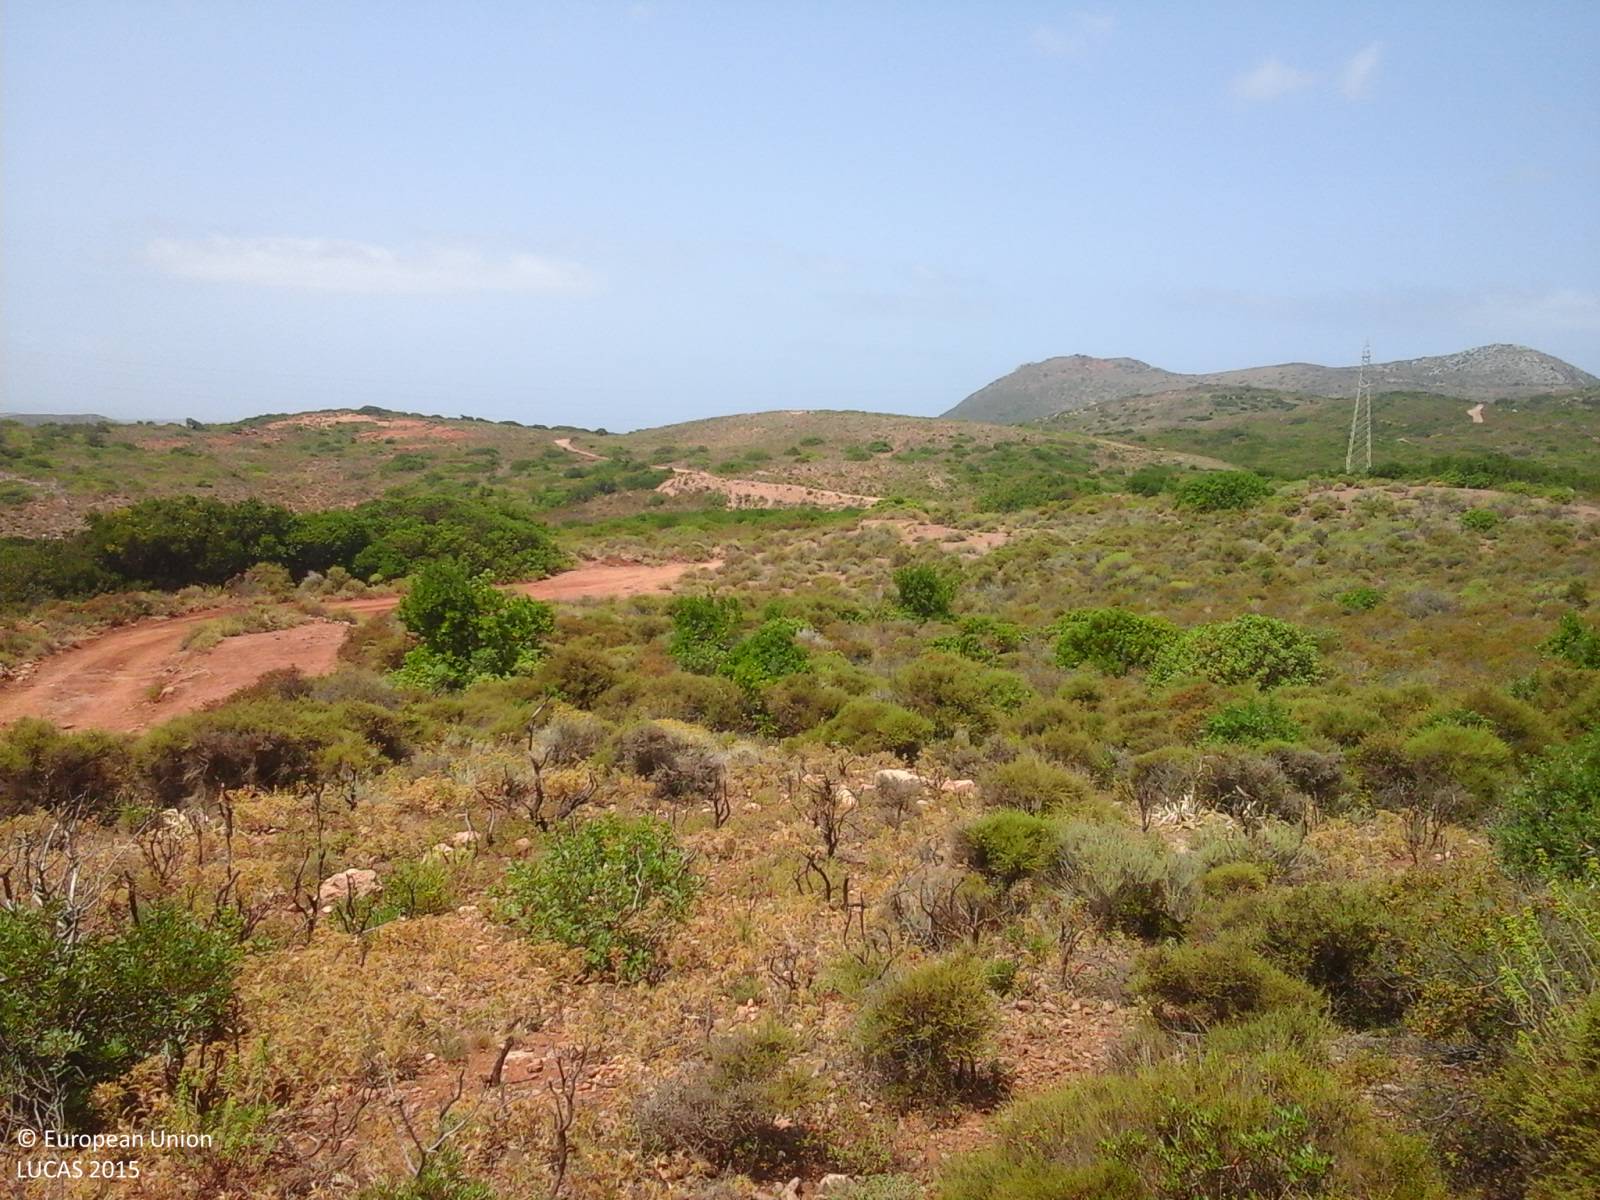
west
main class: Shrubland
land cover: Shrubland without tree cover
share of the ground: > 75 %
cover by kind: shrubs 65 %, unconsolidated bare surface 15 %, herbaceous plants 10 %, consolidated bare surface 10 %
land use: Semi-natural and natural areas not in use
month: July
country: IT
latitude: 39.2779
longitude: 8.5137
